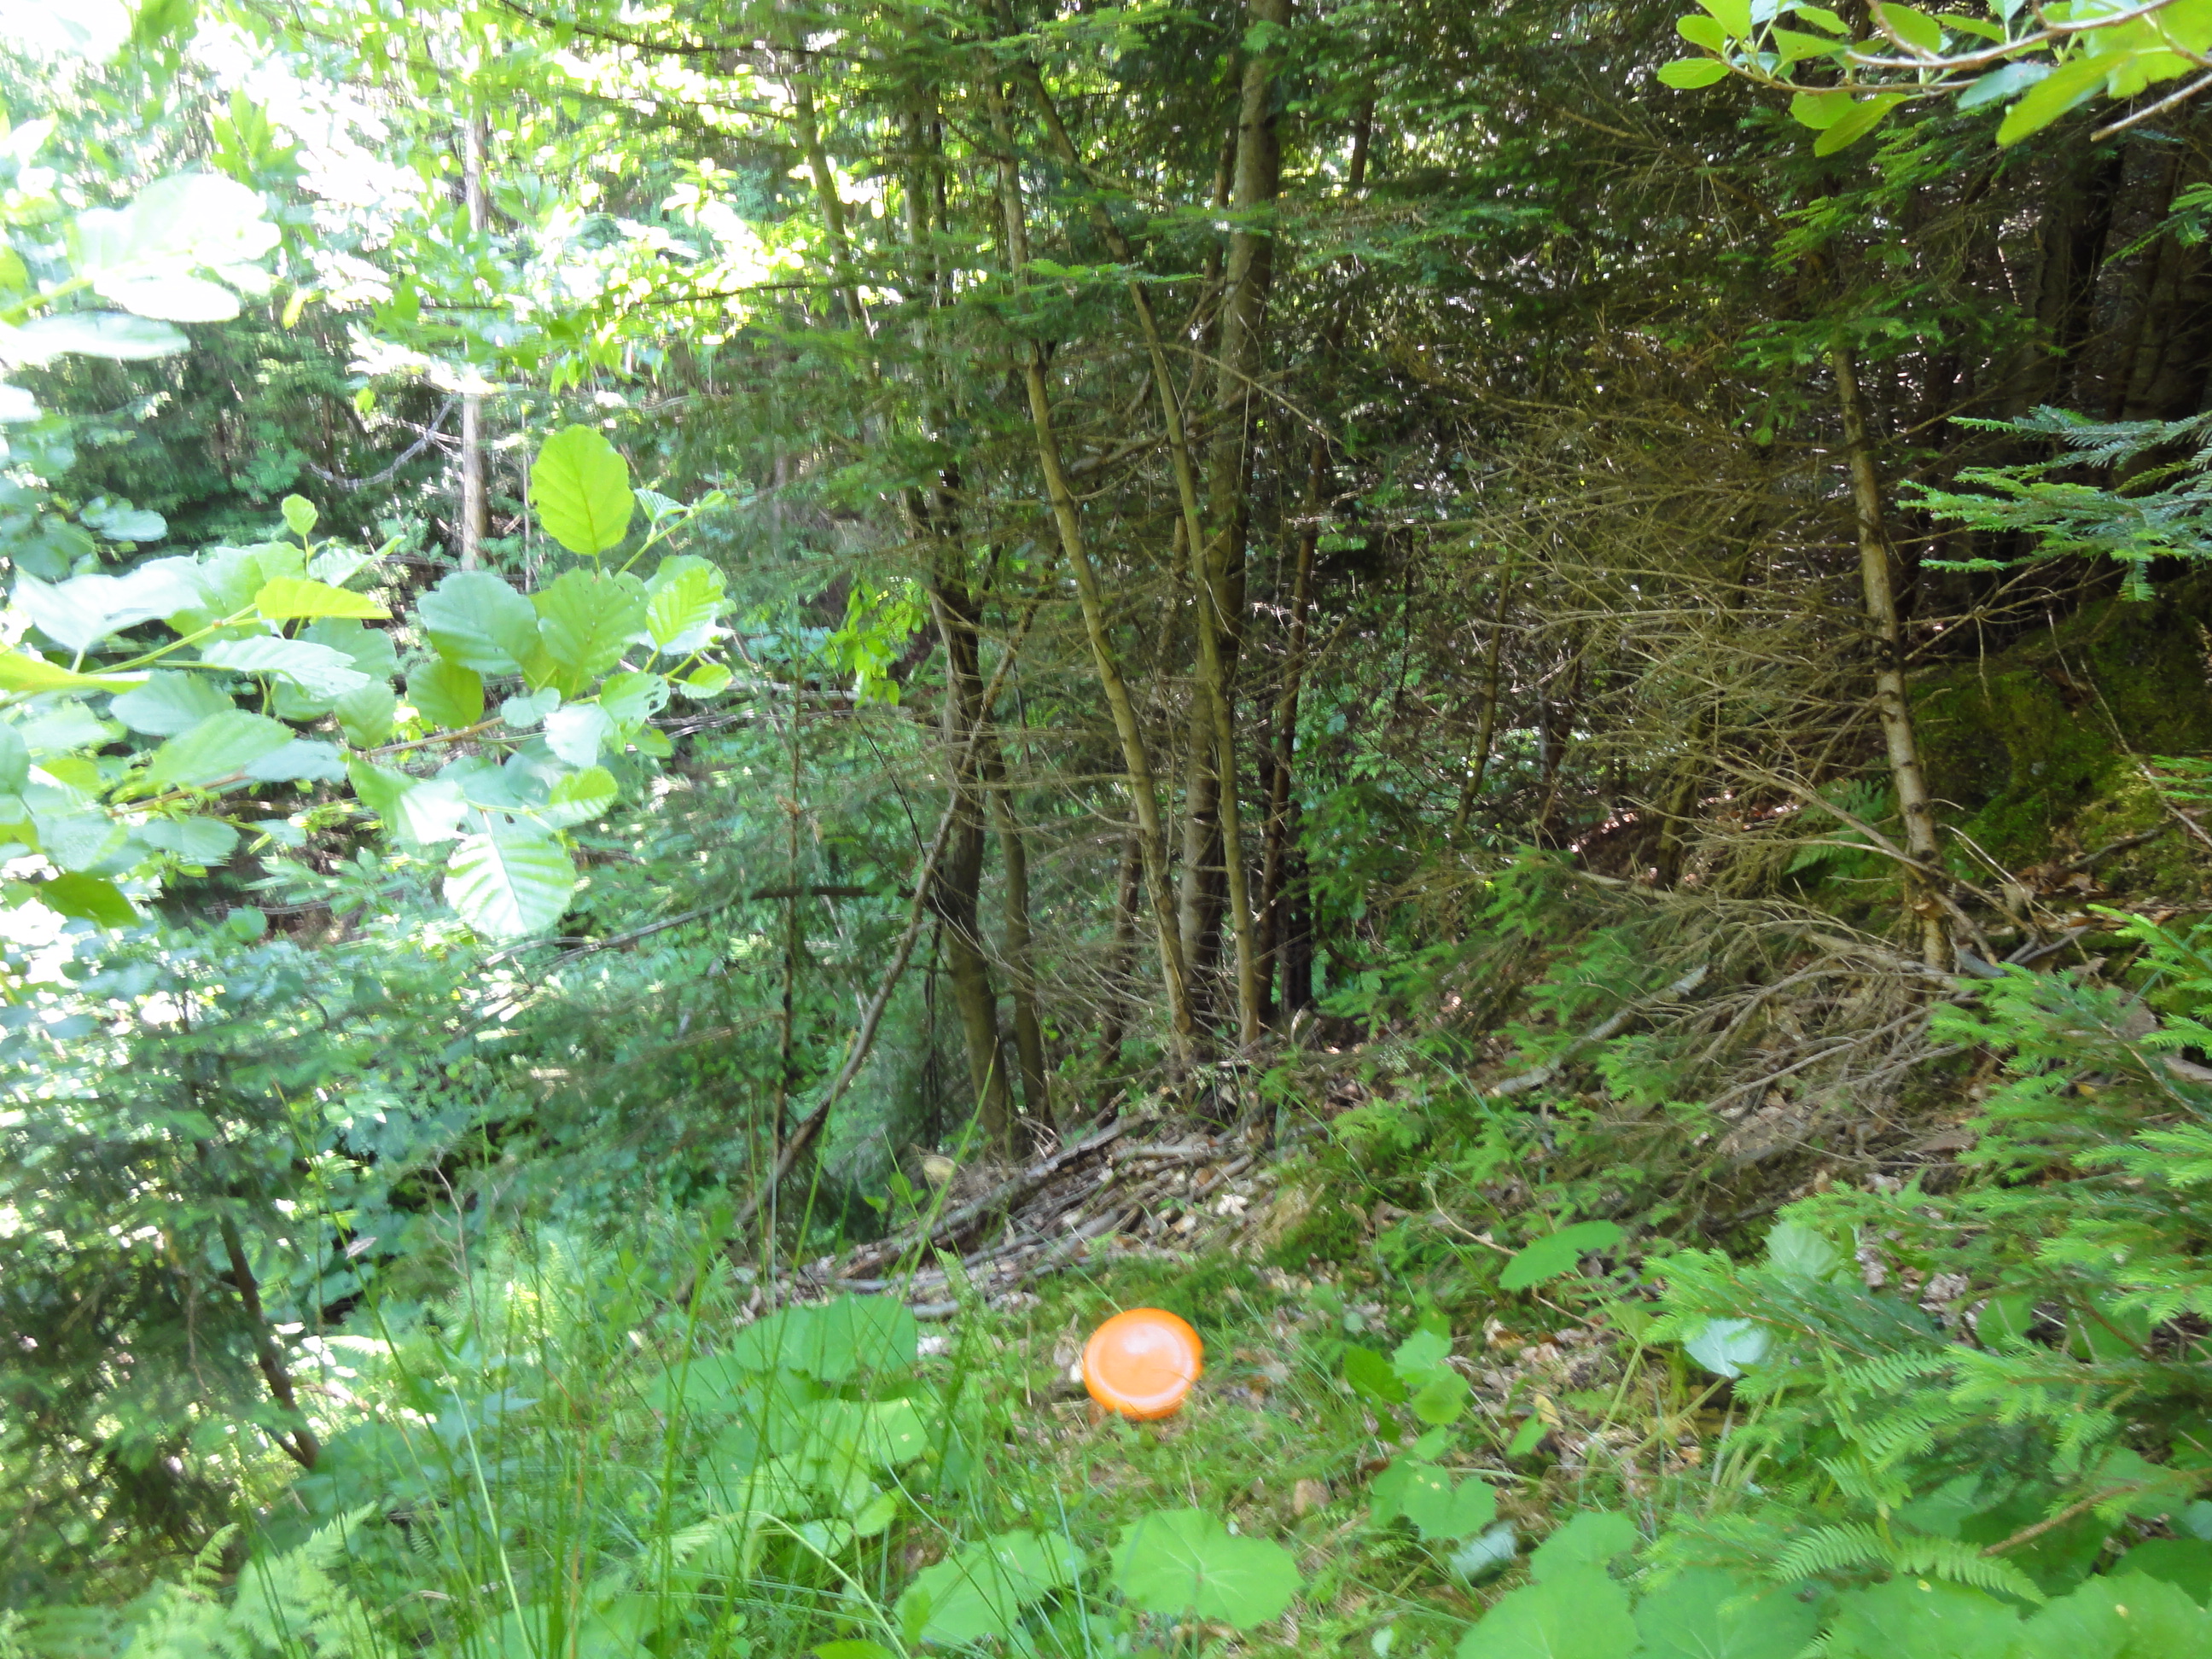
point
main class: Woodland
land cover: Spruce dominated mixed woodland
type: hemiboreal forest and nemoral coniferous forest and mixed broadleaved-coniferous forest
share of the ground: > 75 %
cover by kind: broadleaved forest trees 50 %, coniferous forest trees 40 %, shrubs 5 %, unconsolidated bare surface 5 %
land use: Forestry
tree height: > 5 m
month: June
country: SI
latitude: 46.1964
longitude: 15.0381
